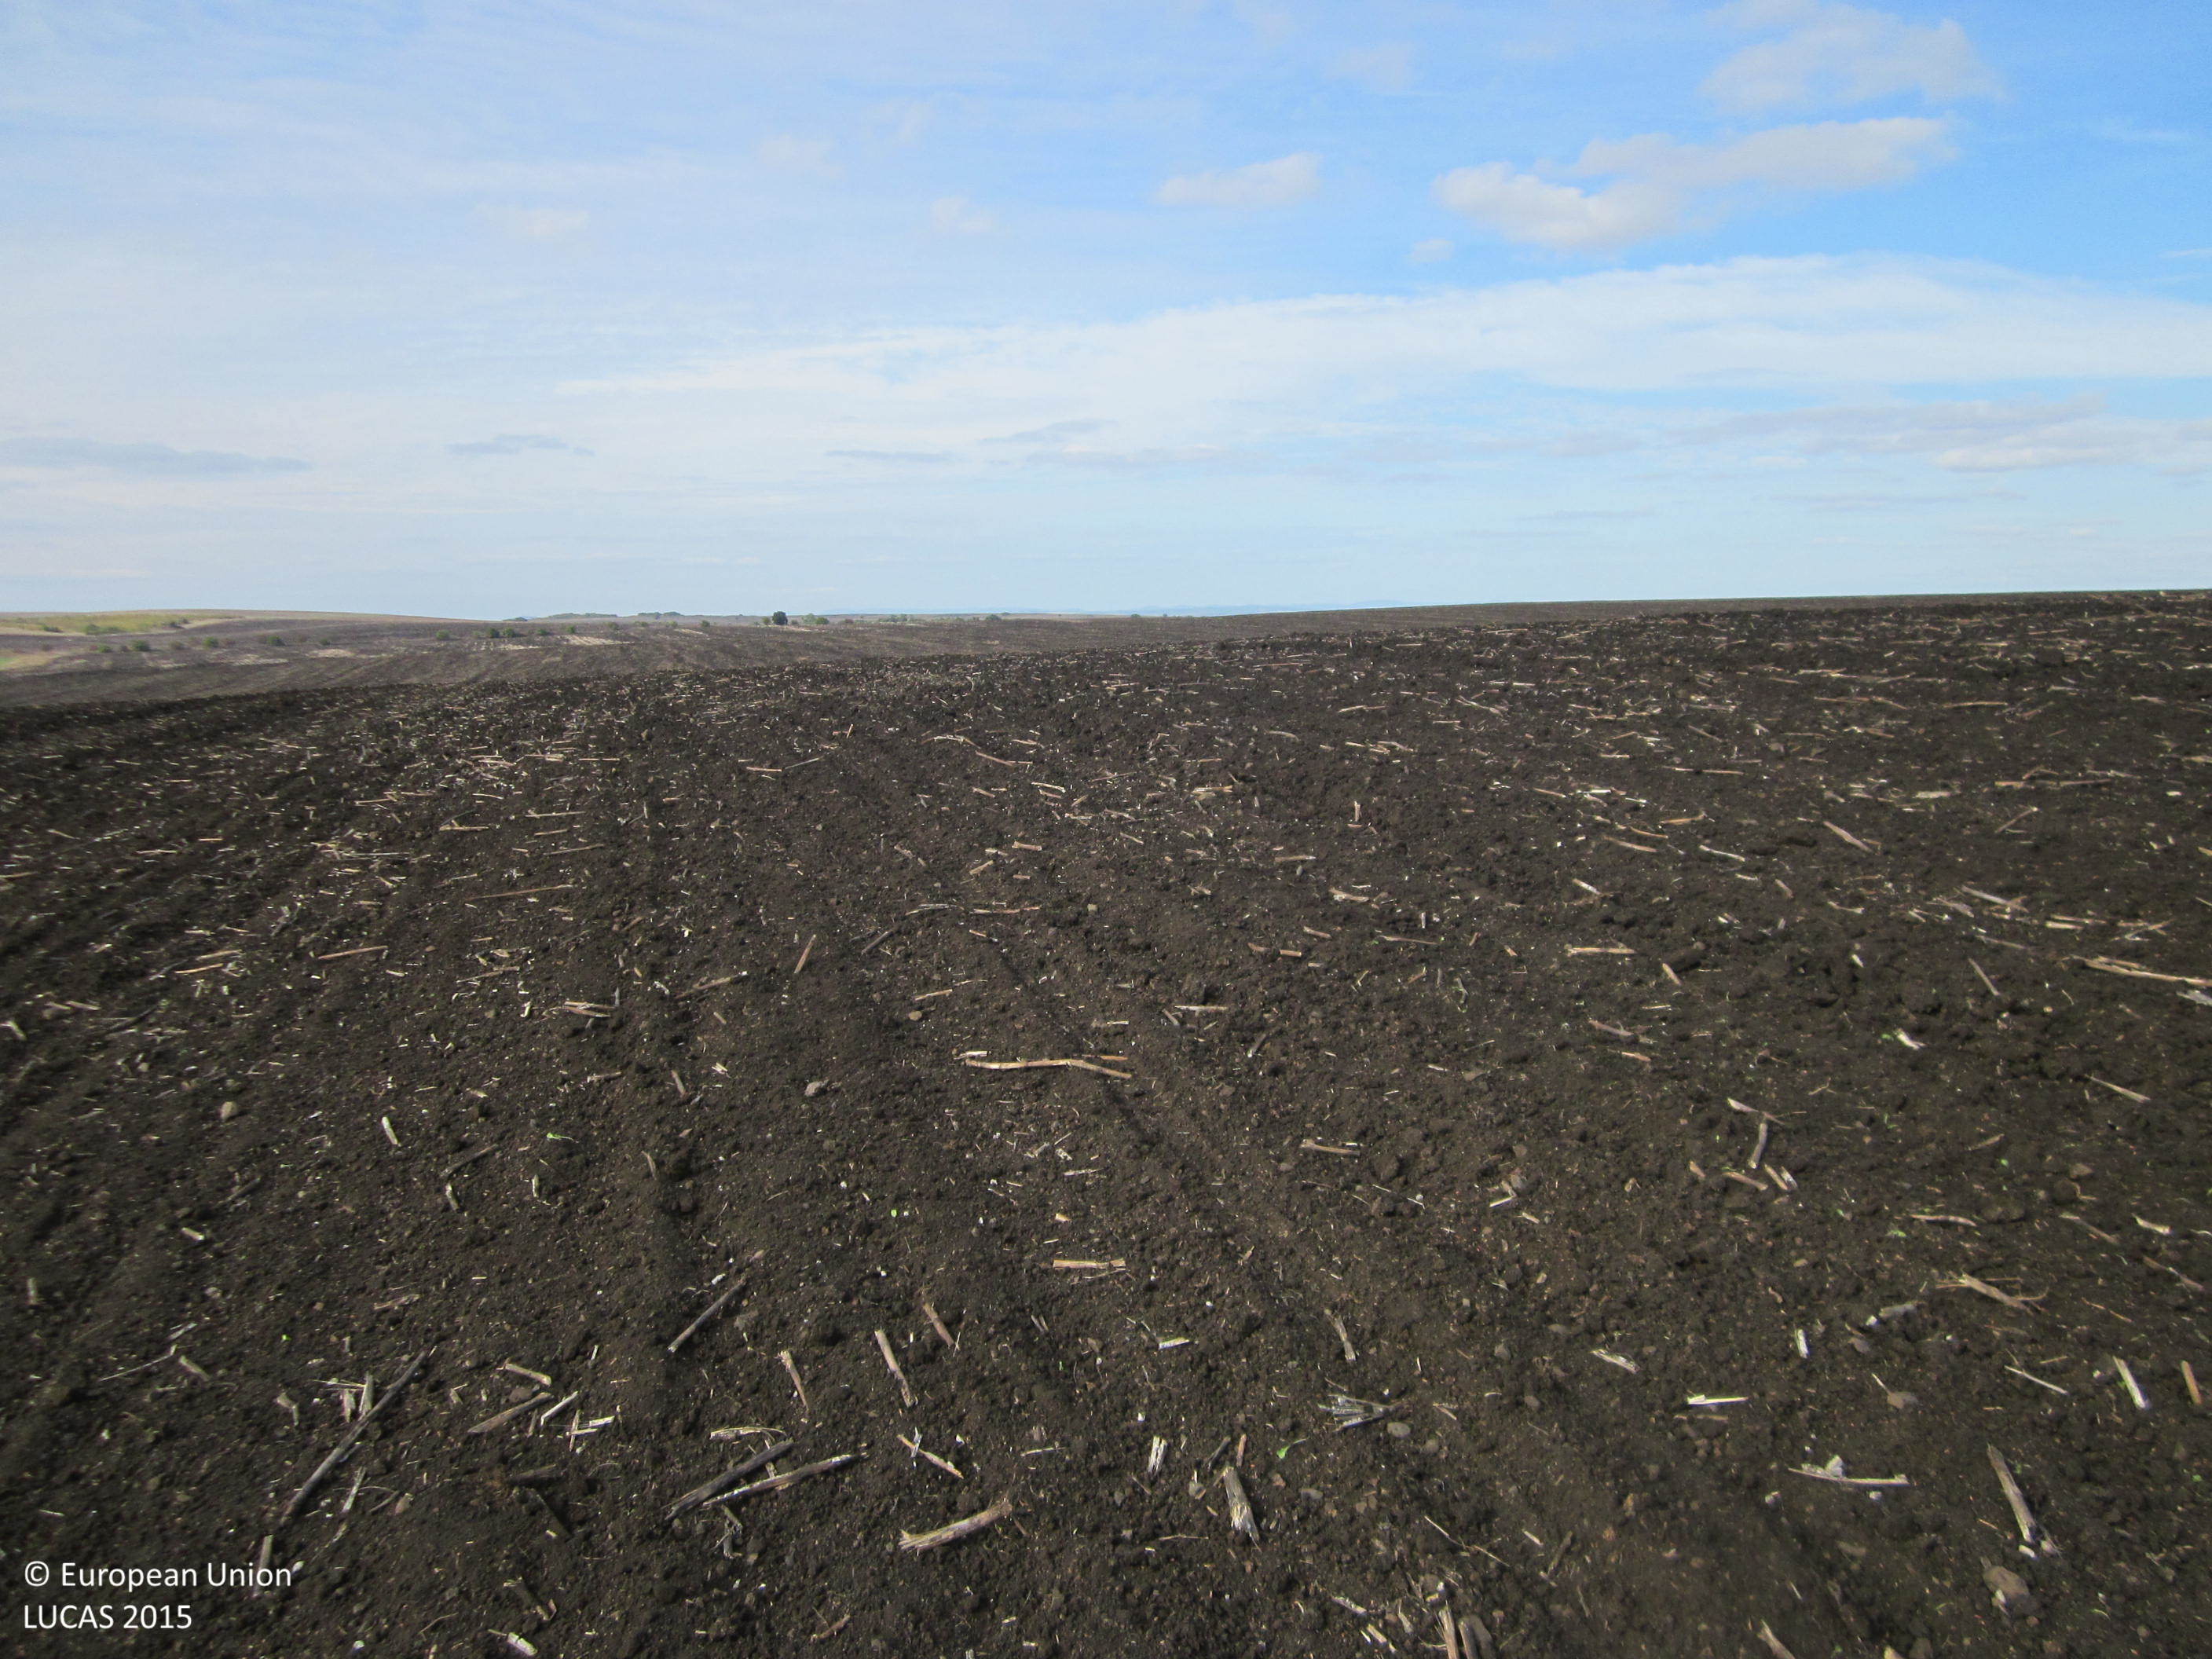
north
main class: Cropland
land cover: Sunflower
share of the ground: < 10 %
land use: Agriculture (excluding fallow land and kitchen gardens)
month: October
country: BG
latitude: 42.4278
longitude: 27.0608
